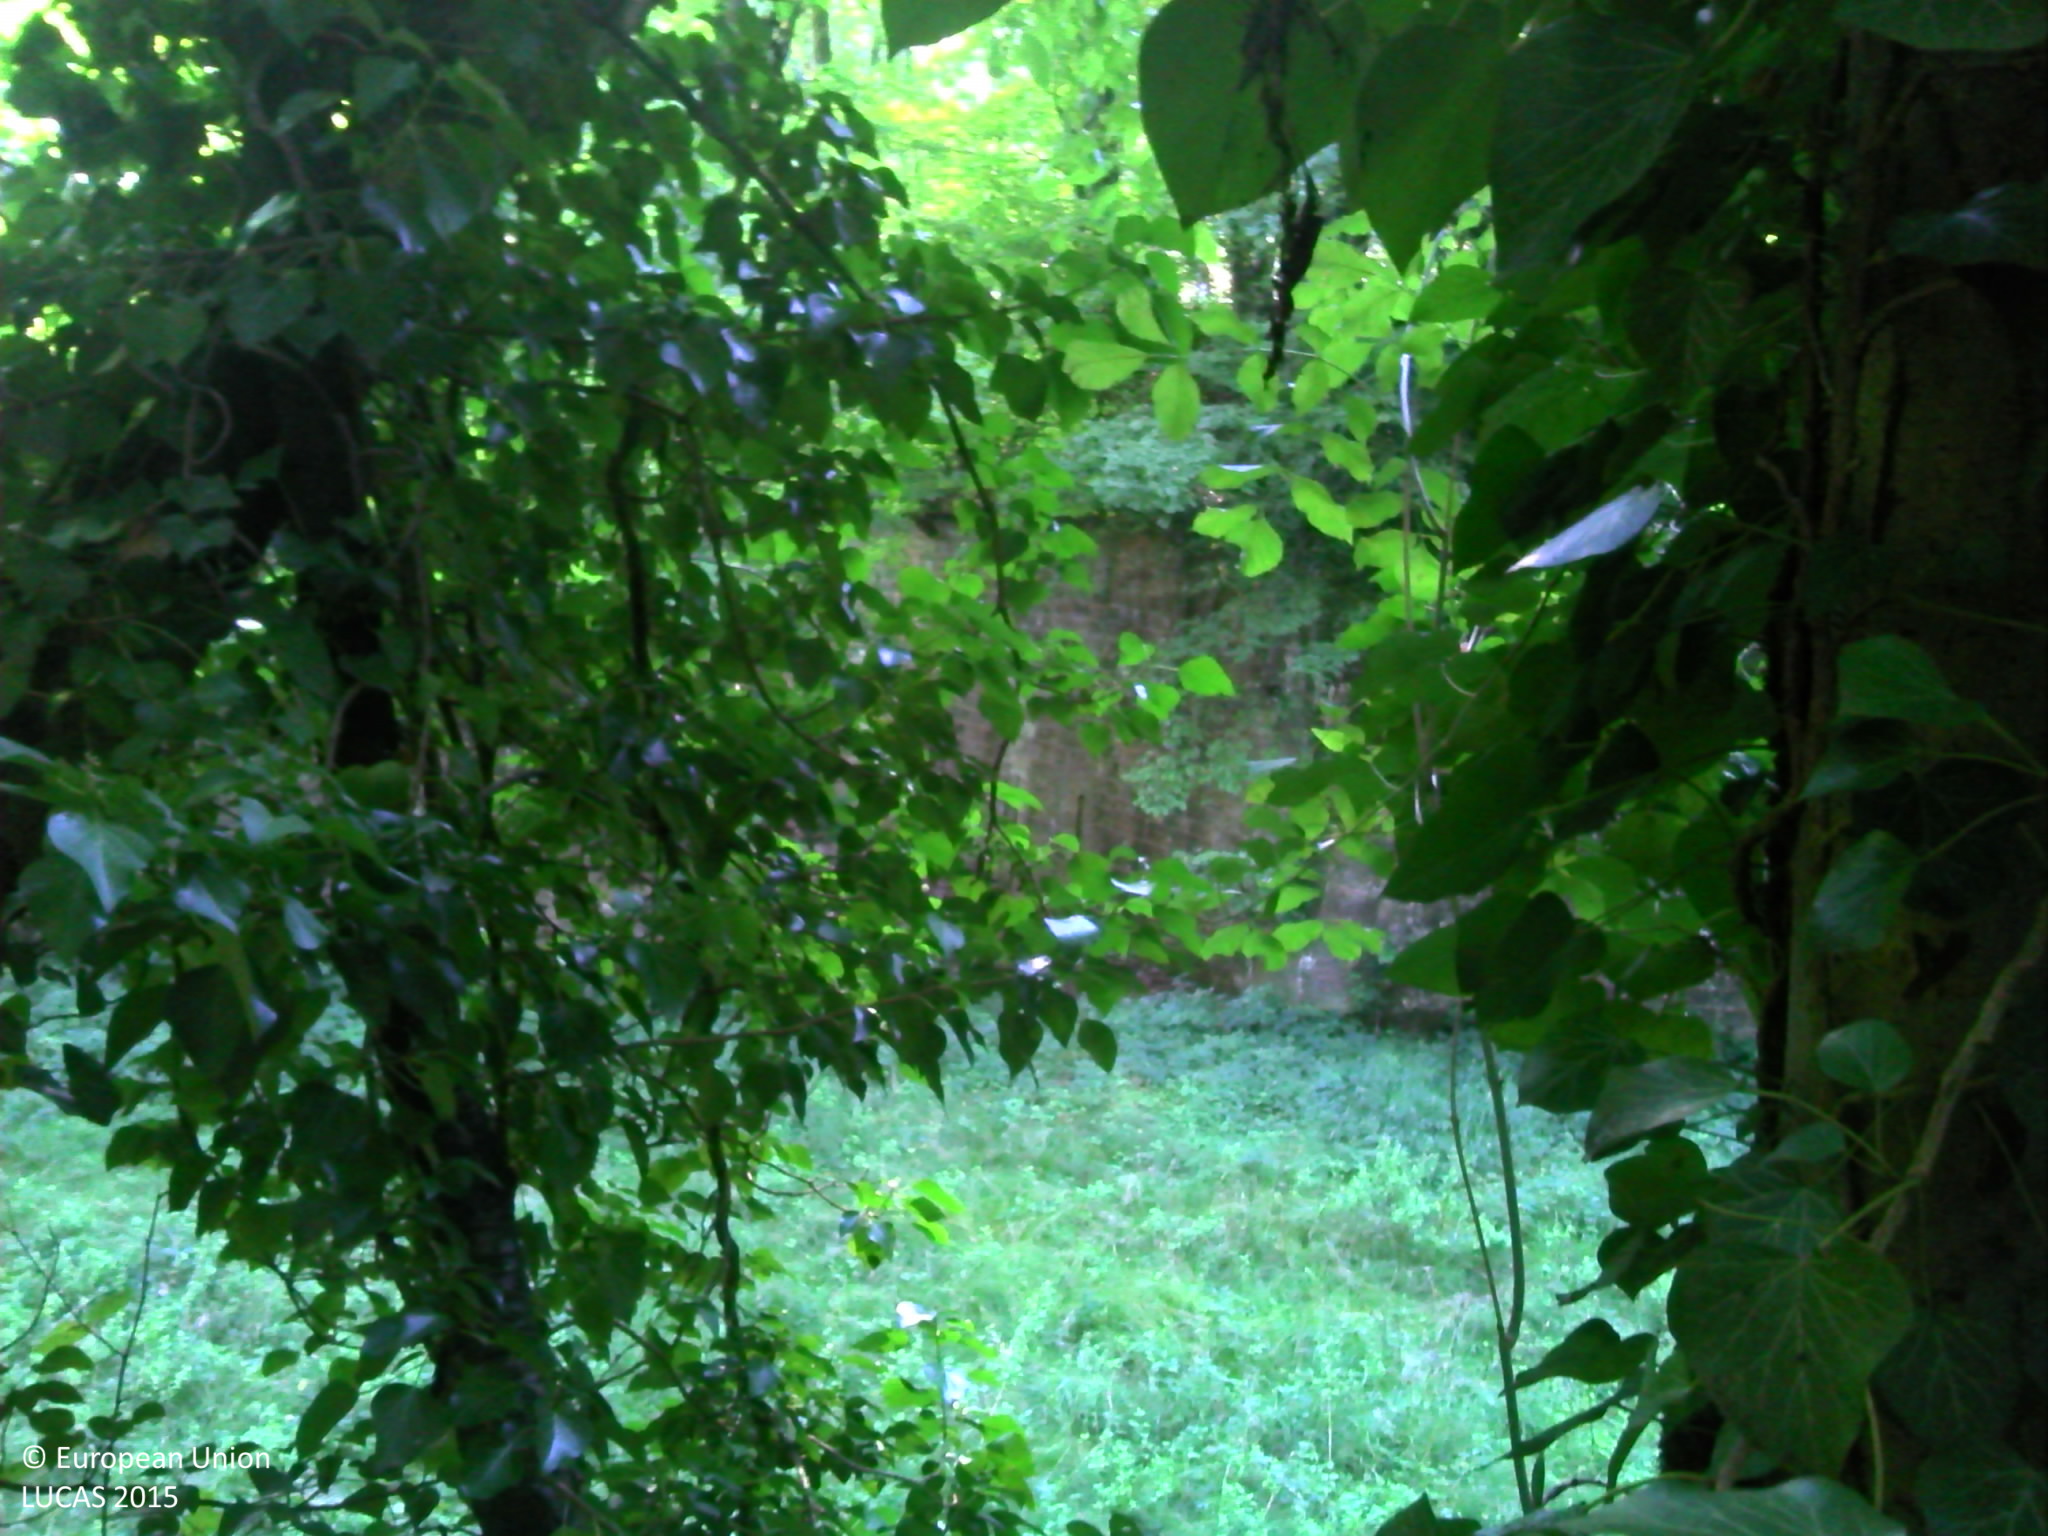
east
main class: Woodland
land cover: Broadleaved woodland
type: mesophytic deciduous forest
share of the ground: > 75 %
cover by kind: broadleaved forest trees 100 %
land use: Amenities, museums, leisure
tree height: > 5 m
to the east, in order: Broadleaved woodland; Artificial constructions; Grassland without tree/shrub cover; Artificial constructions; Broadleaved woodland; Grassland without tree/shrub cover; Tracks; Broadleaved woodland; Grassland without tree/shrub cover; Artificial constructions in urban areas
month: August
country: FR
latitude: 47.6382
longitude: 6.8471
